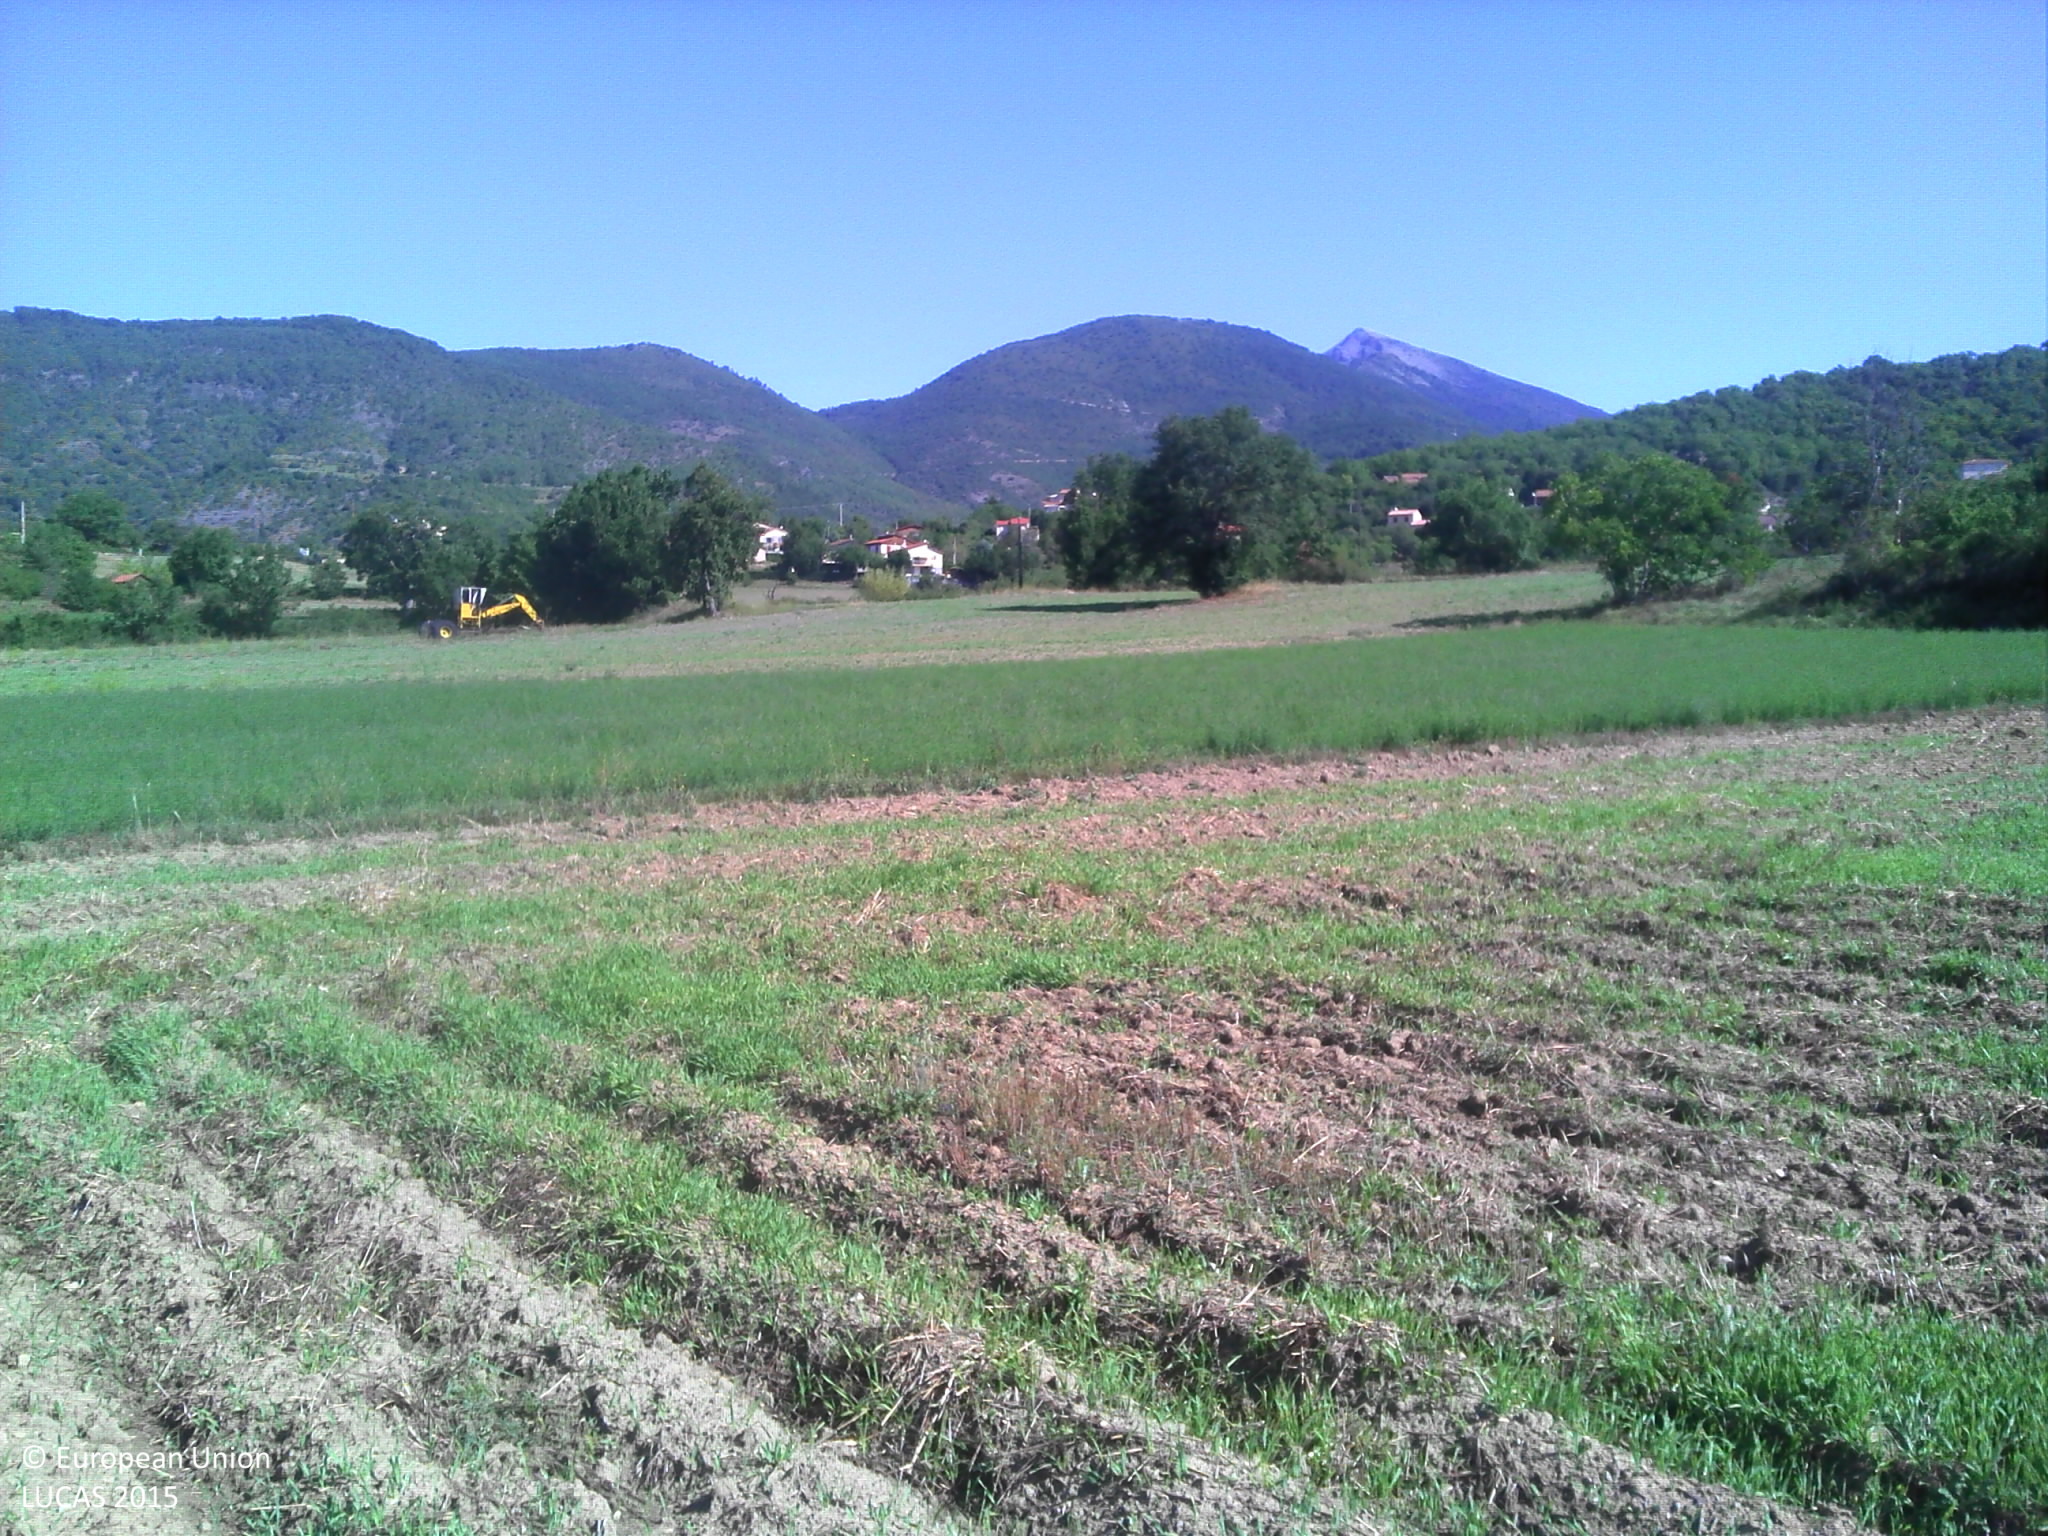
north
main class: Grassland
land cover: Grassland without tree/shrub cover
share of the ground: > 75 %
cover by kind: unconsolidated bare surface 60 %, herbaceous plants 40 %
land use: Agriculture (excluding fallow land and kitchen gardens)
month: August
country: FR
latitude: 44.1580
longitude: 6.2936
